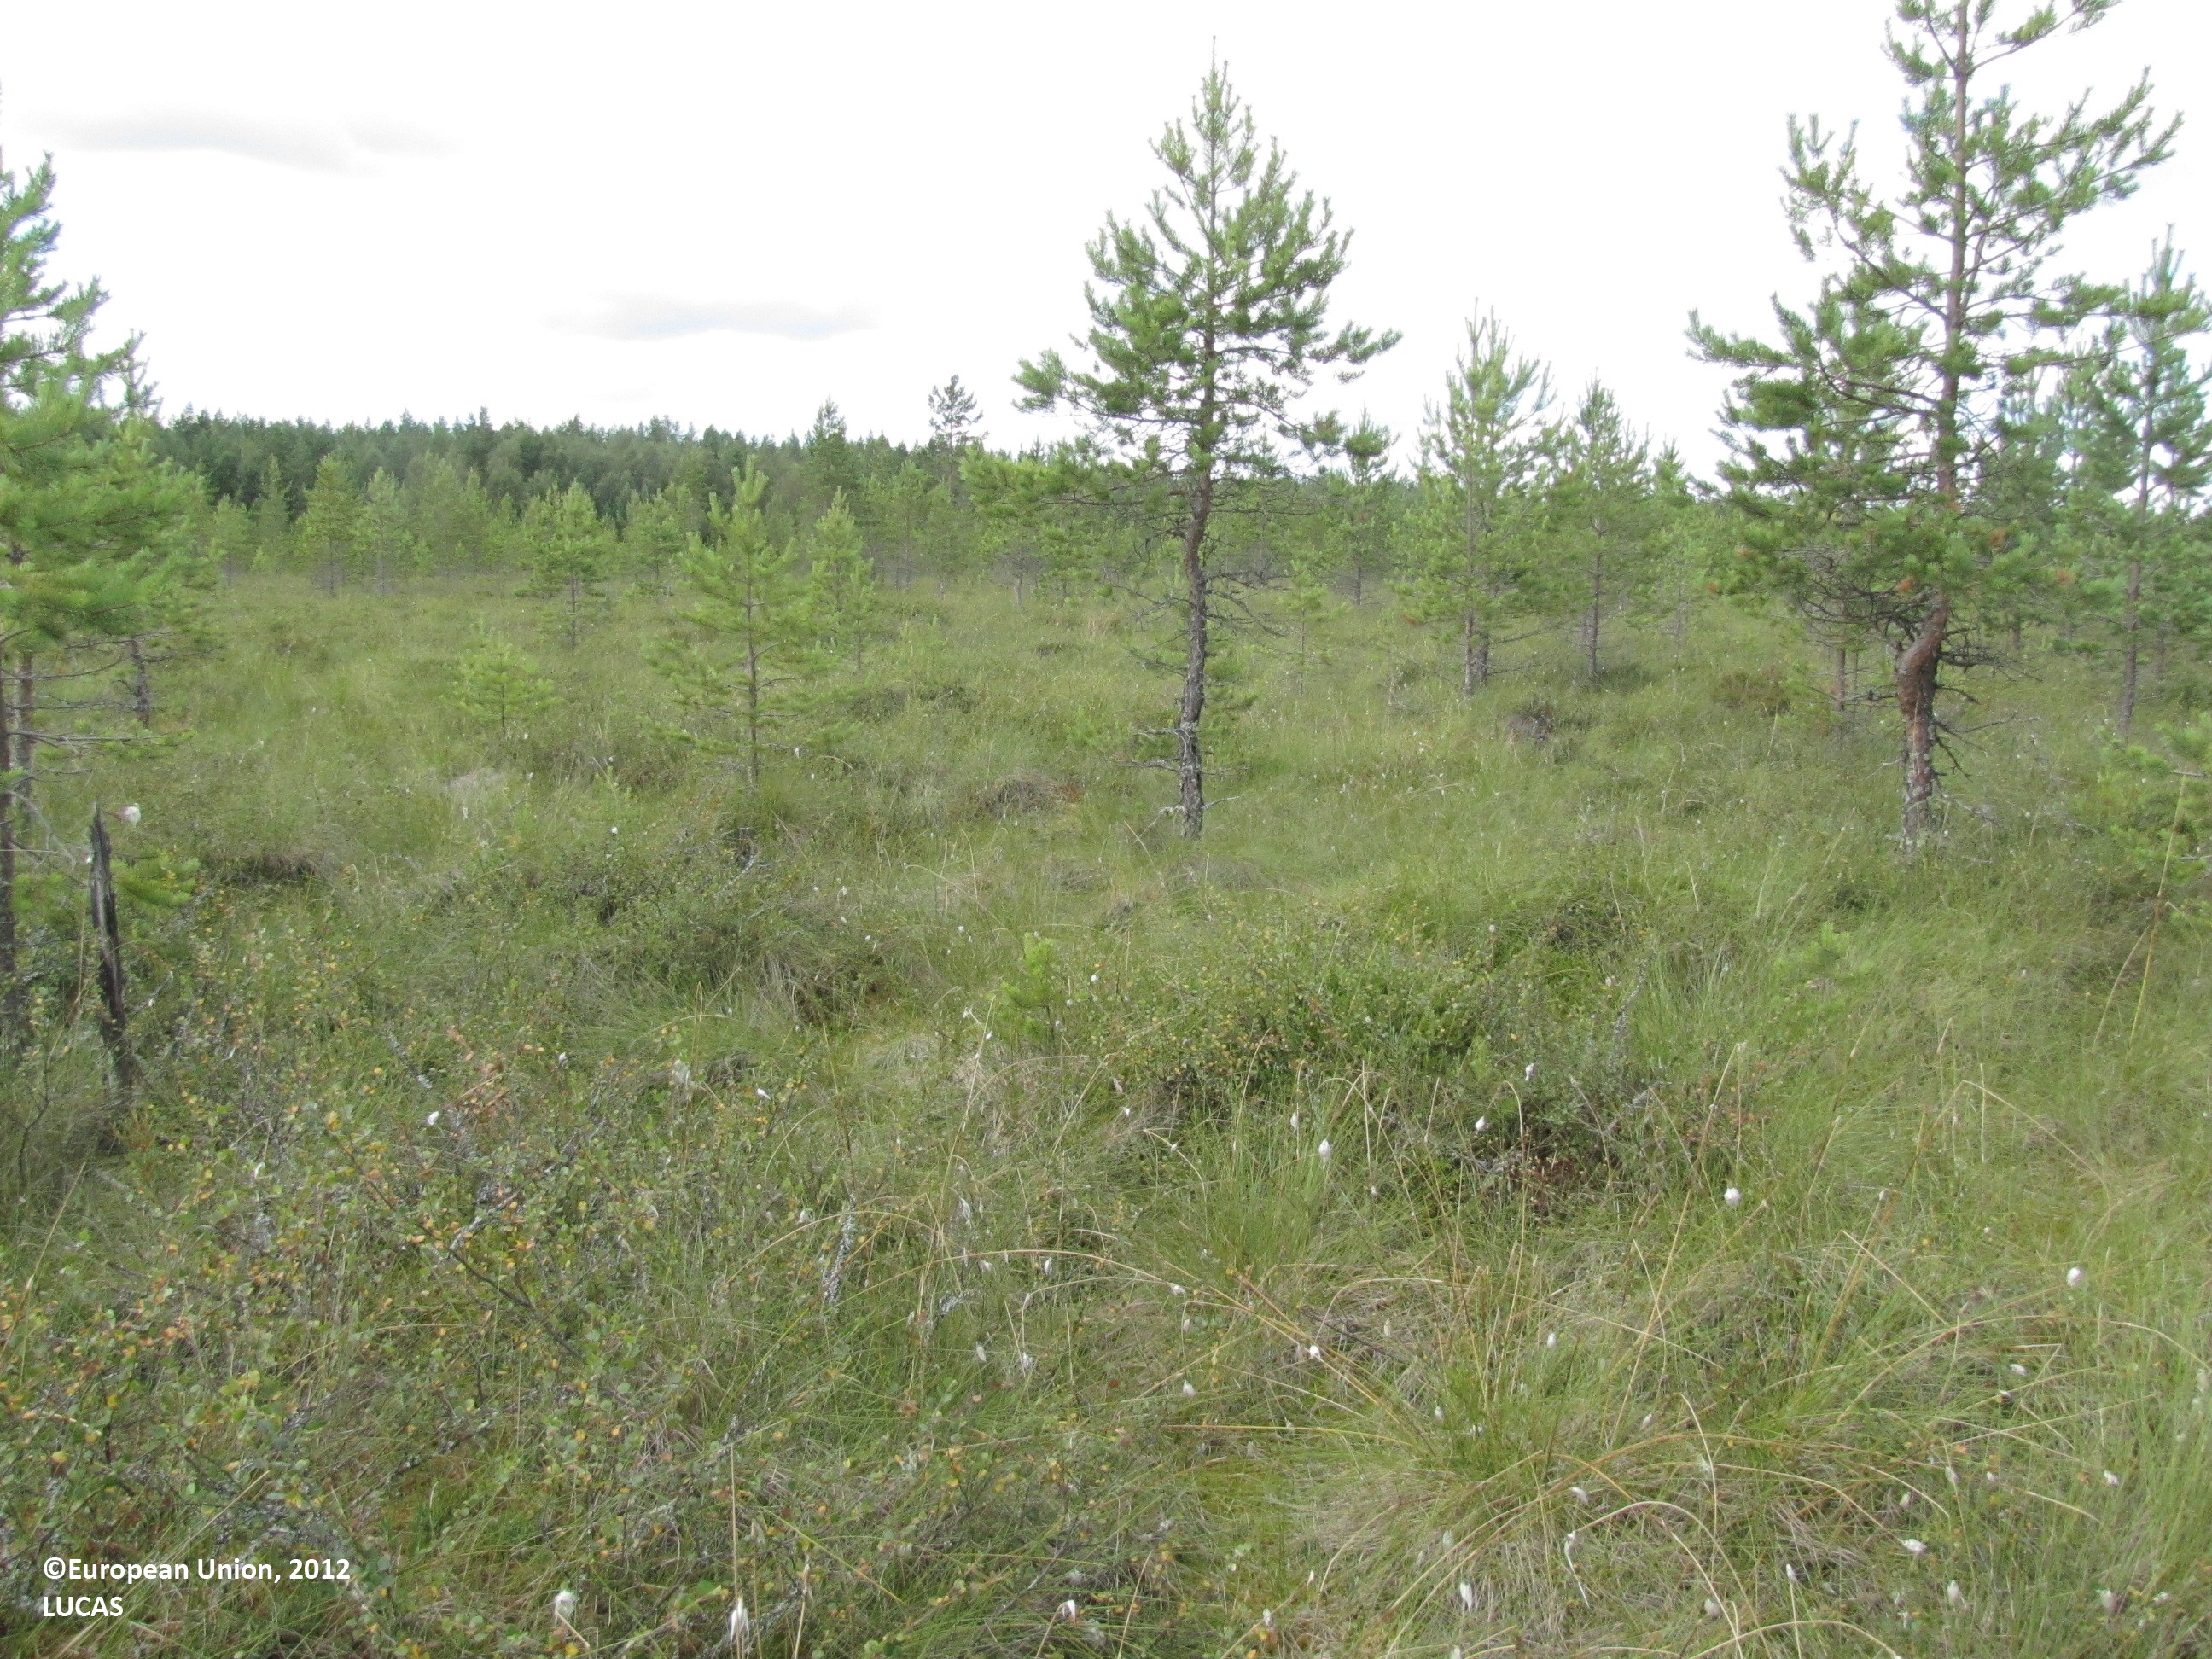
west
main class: Woodland
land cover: Pine dominated coniferous woodland
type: mire and swamp forests
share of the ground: 25 - 50 %
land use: Forestry
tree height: < 5 m
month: July
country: FI
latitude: 62.2750
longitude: 23.3067
